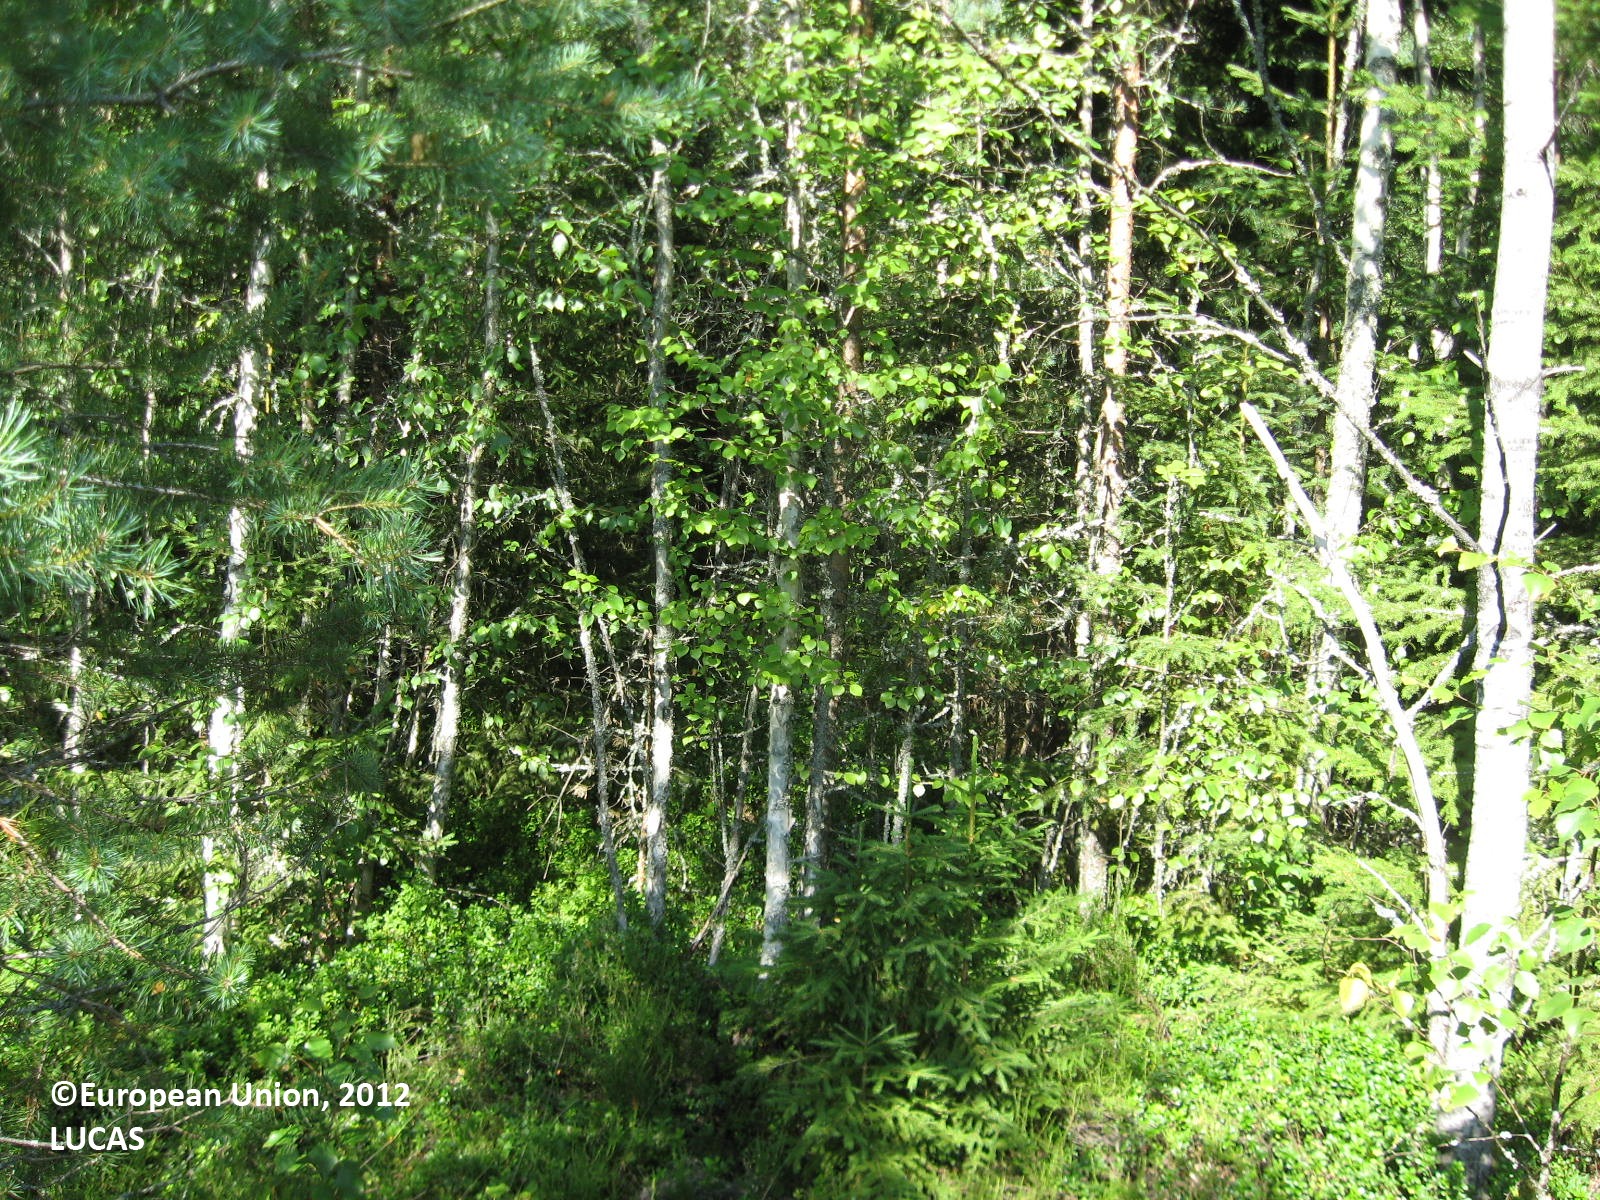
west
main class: Woodland
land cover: Other mixed woodland
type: boreal forest
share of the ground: > 75 %
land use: Forestry
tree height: > 5 m
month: July
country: FI
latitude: 61.8652
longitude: 22.5509
